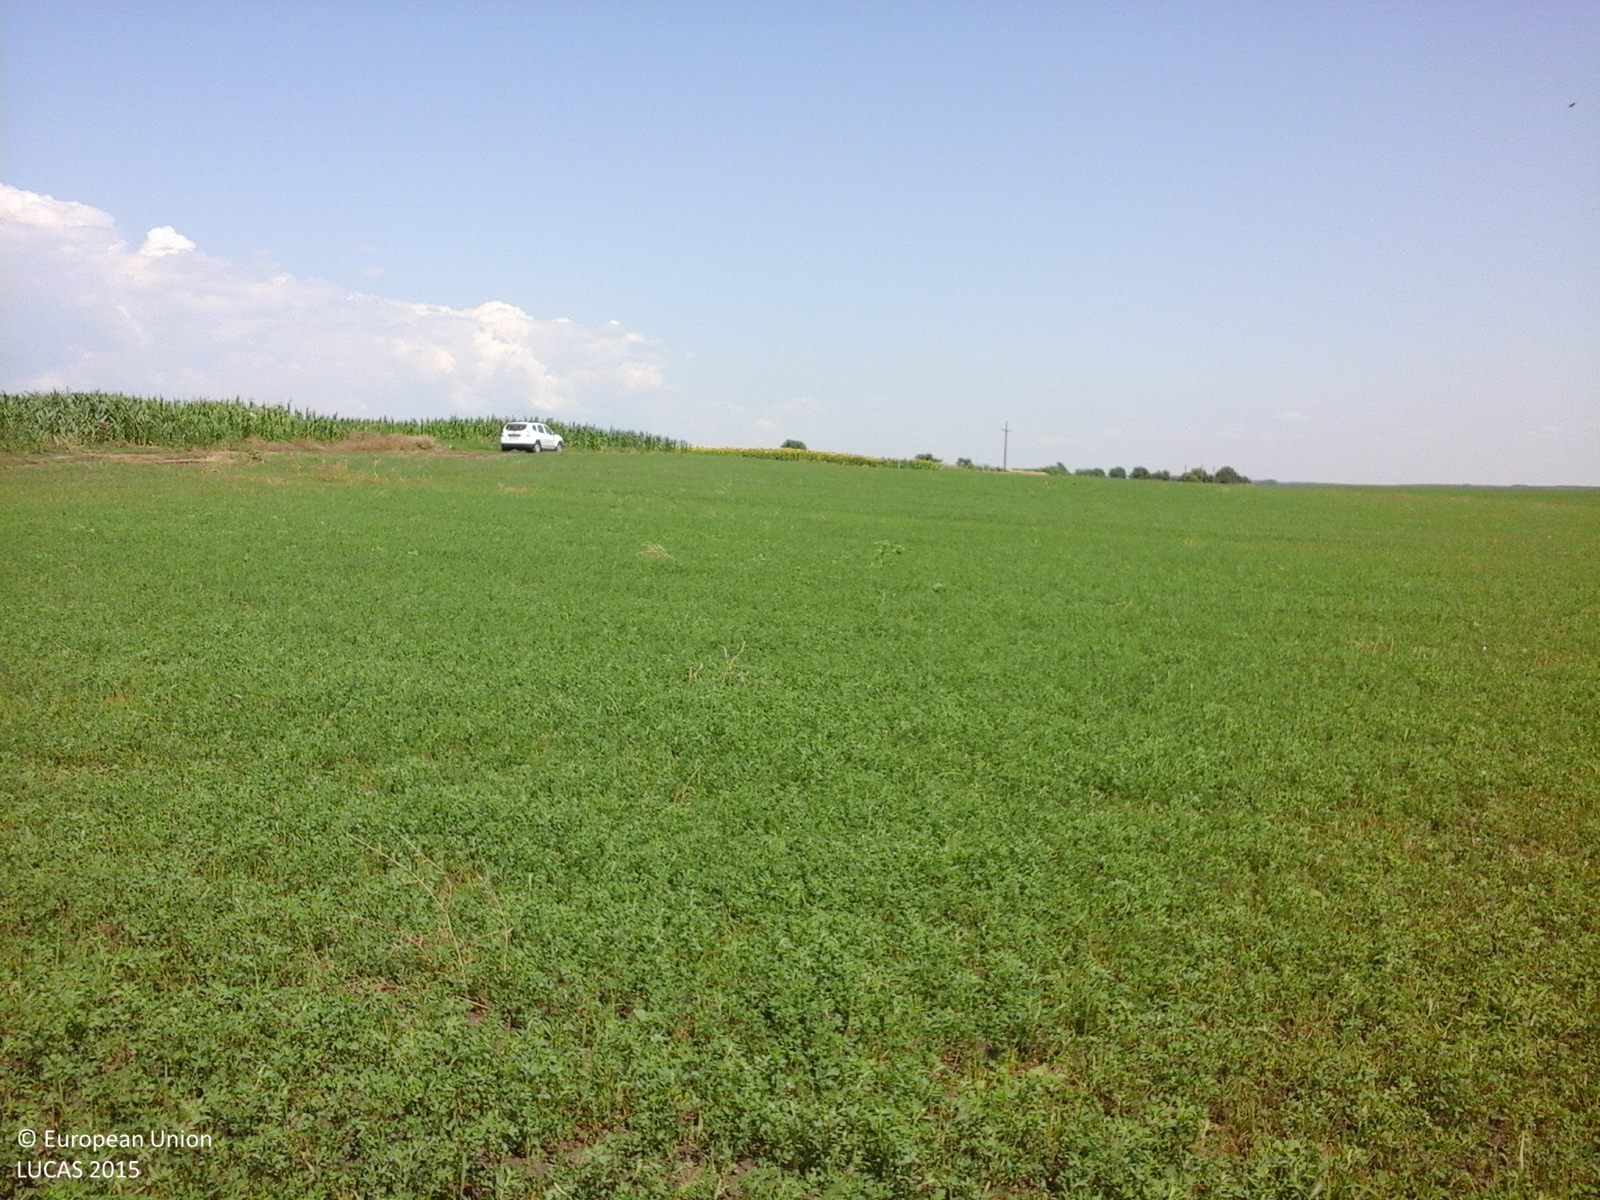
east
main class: Cropland
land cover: Lucerne
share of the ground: > 75 %
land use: Agriculture (excluding fallow land and kitchen gardens)
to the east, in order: Lucerne; Tracks; Maize; Common wheat; Maize
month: July
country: RO
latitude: 43.9427
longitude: 26.0077
